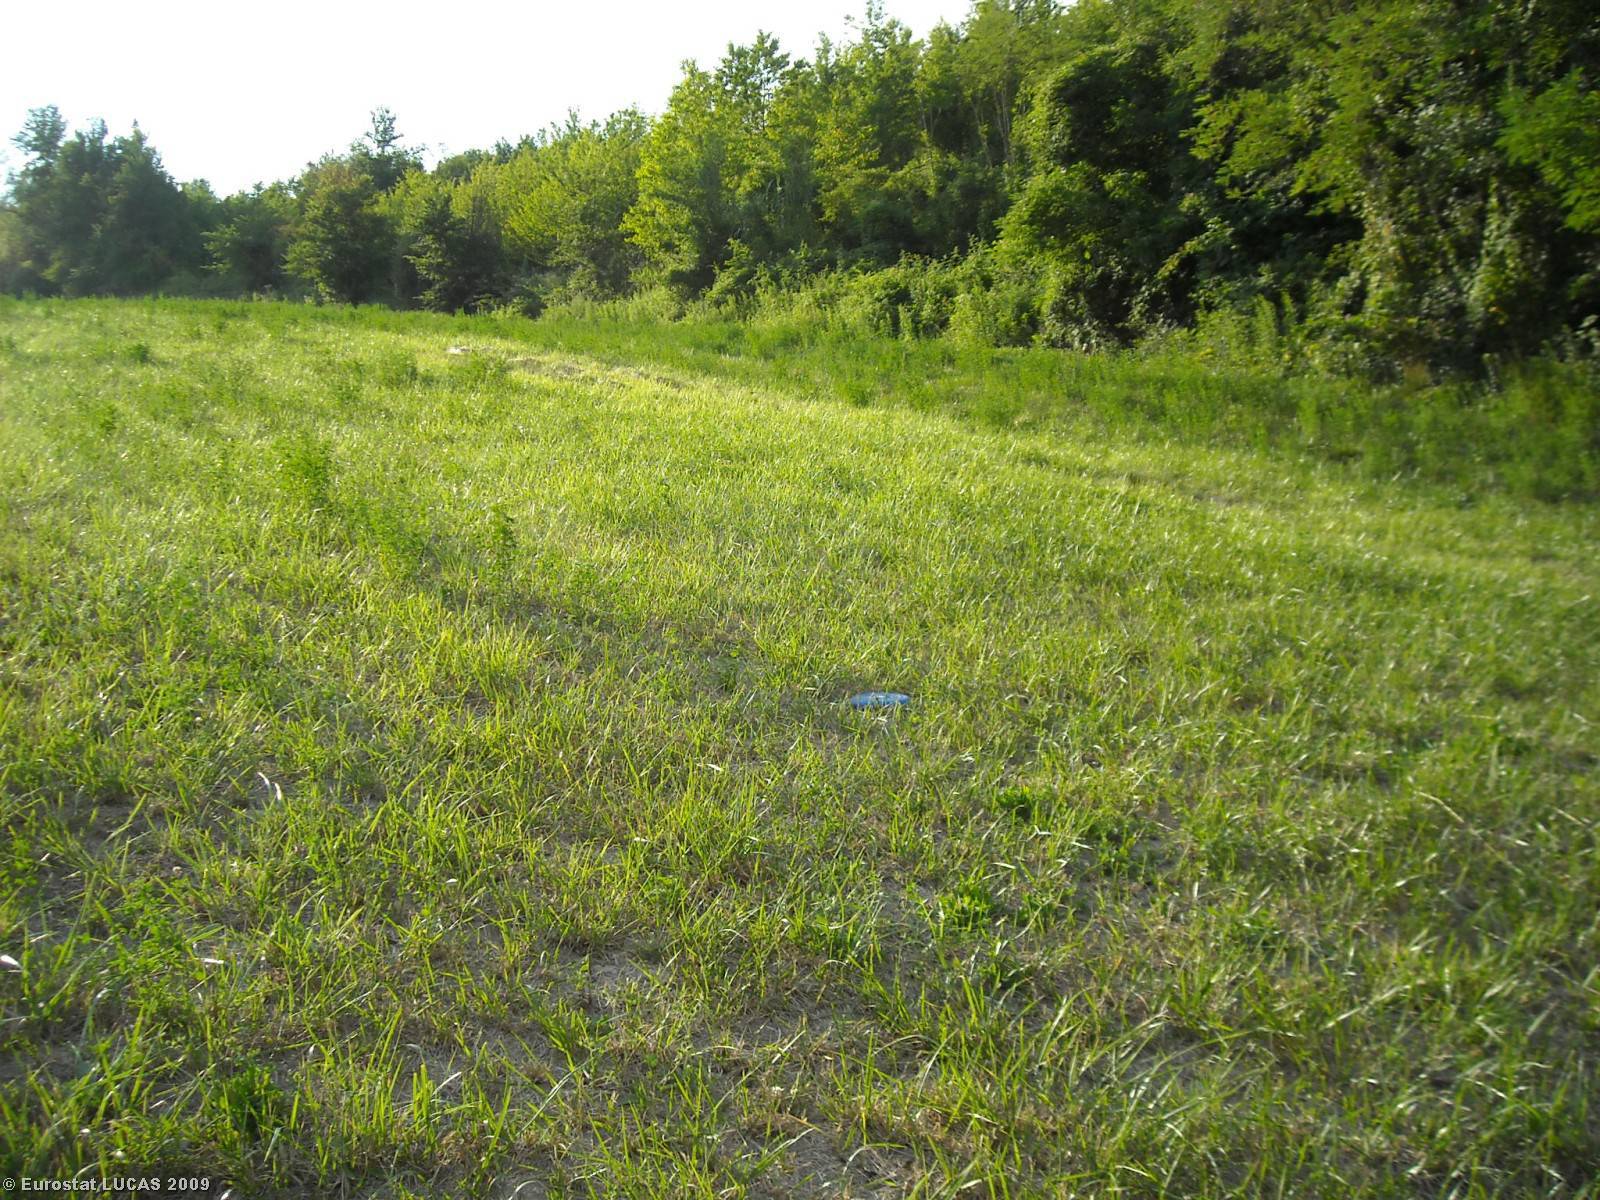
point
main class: Grassland
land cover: Grassland without tree/shrub cover
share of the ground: > 75 %
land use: Agriculture (excluding fallow land and kitchen gardens)
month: June
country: IT
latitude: 45.1264
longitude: 8.0836
